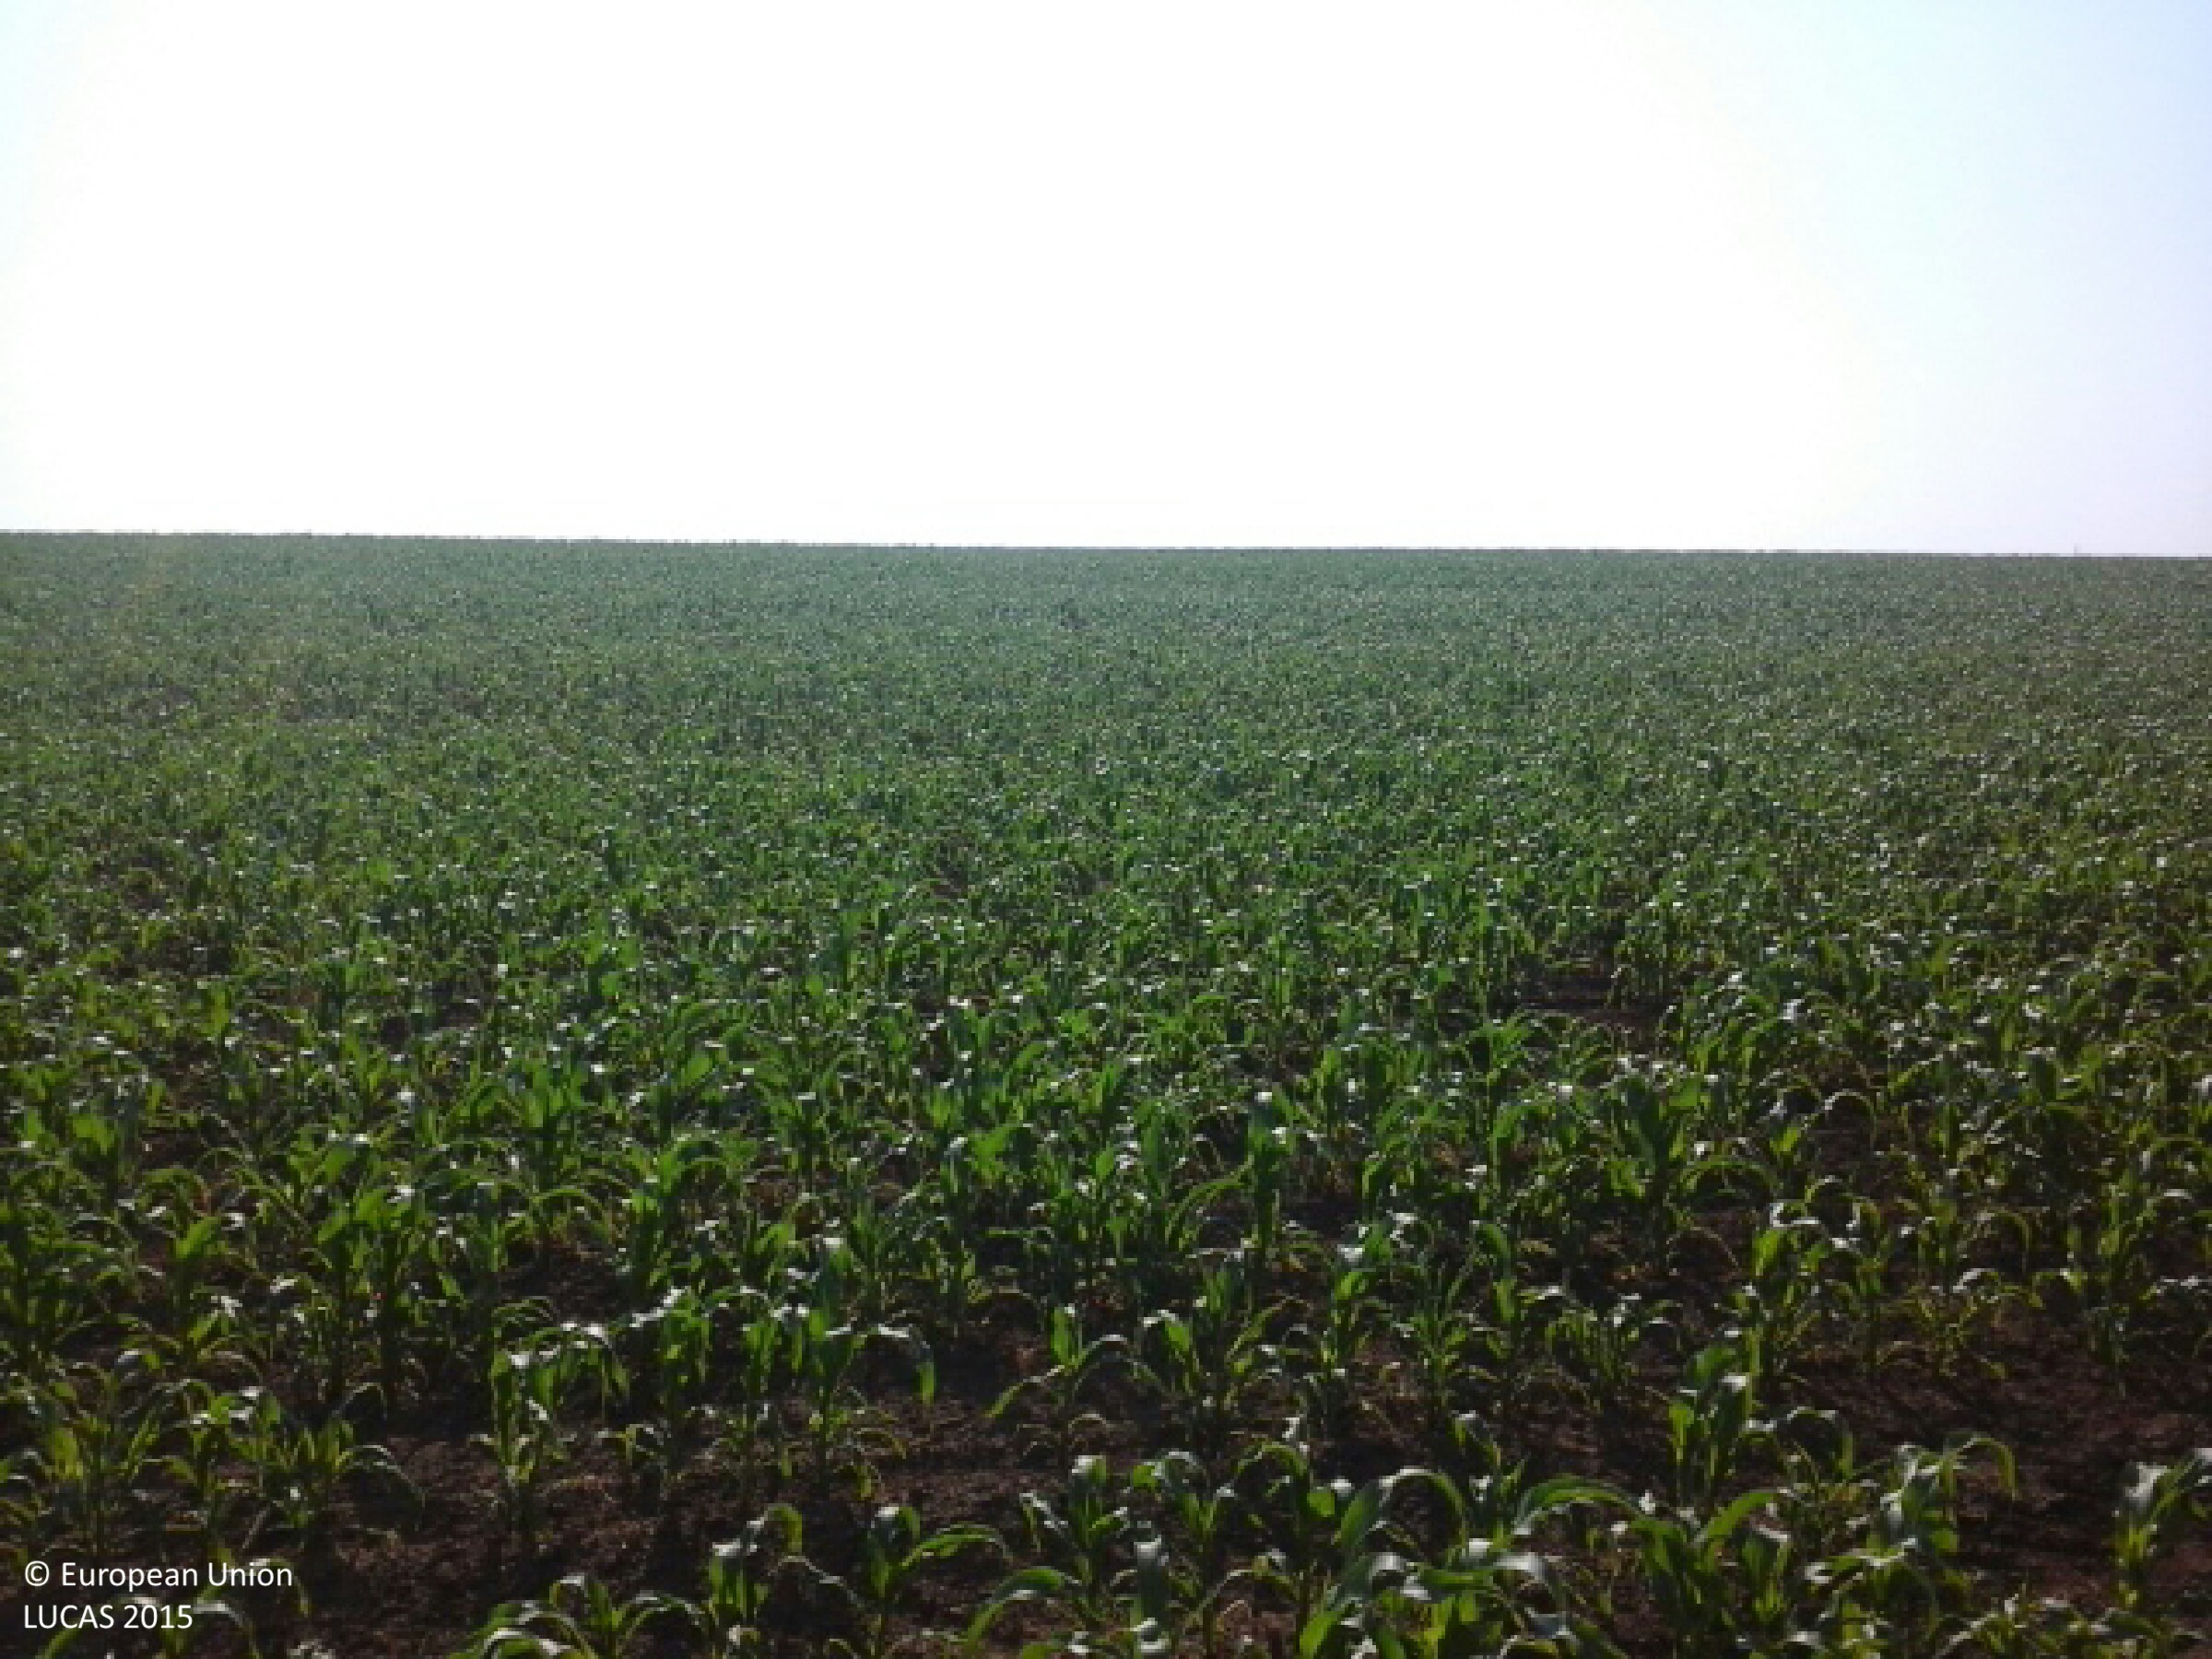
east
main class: Cropland
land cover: Maize
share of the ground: 25 - 50 %
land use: Agriculture (excluding fallow land and kitchen gardens)
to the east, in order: Maize
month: July
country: HU
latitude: 48.1743
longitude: 21.0540
